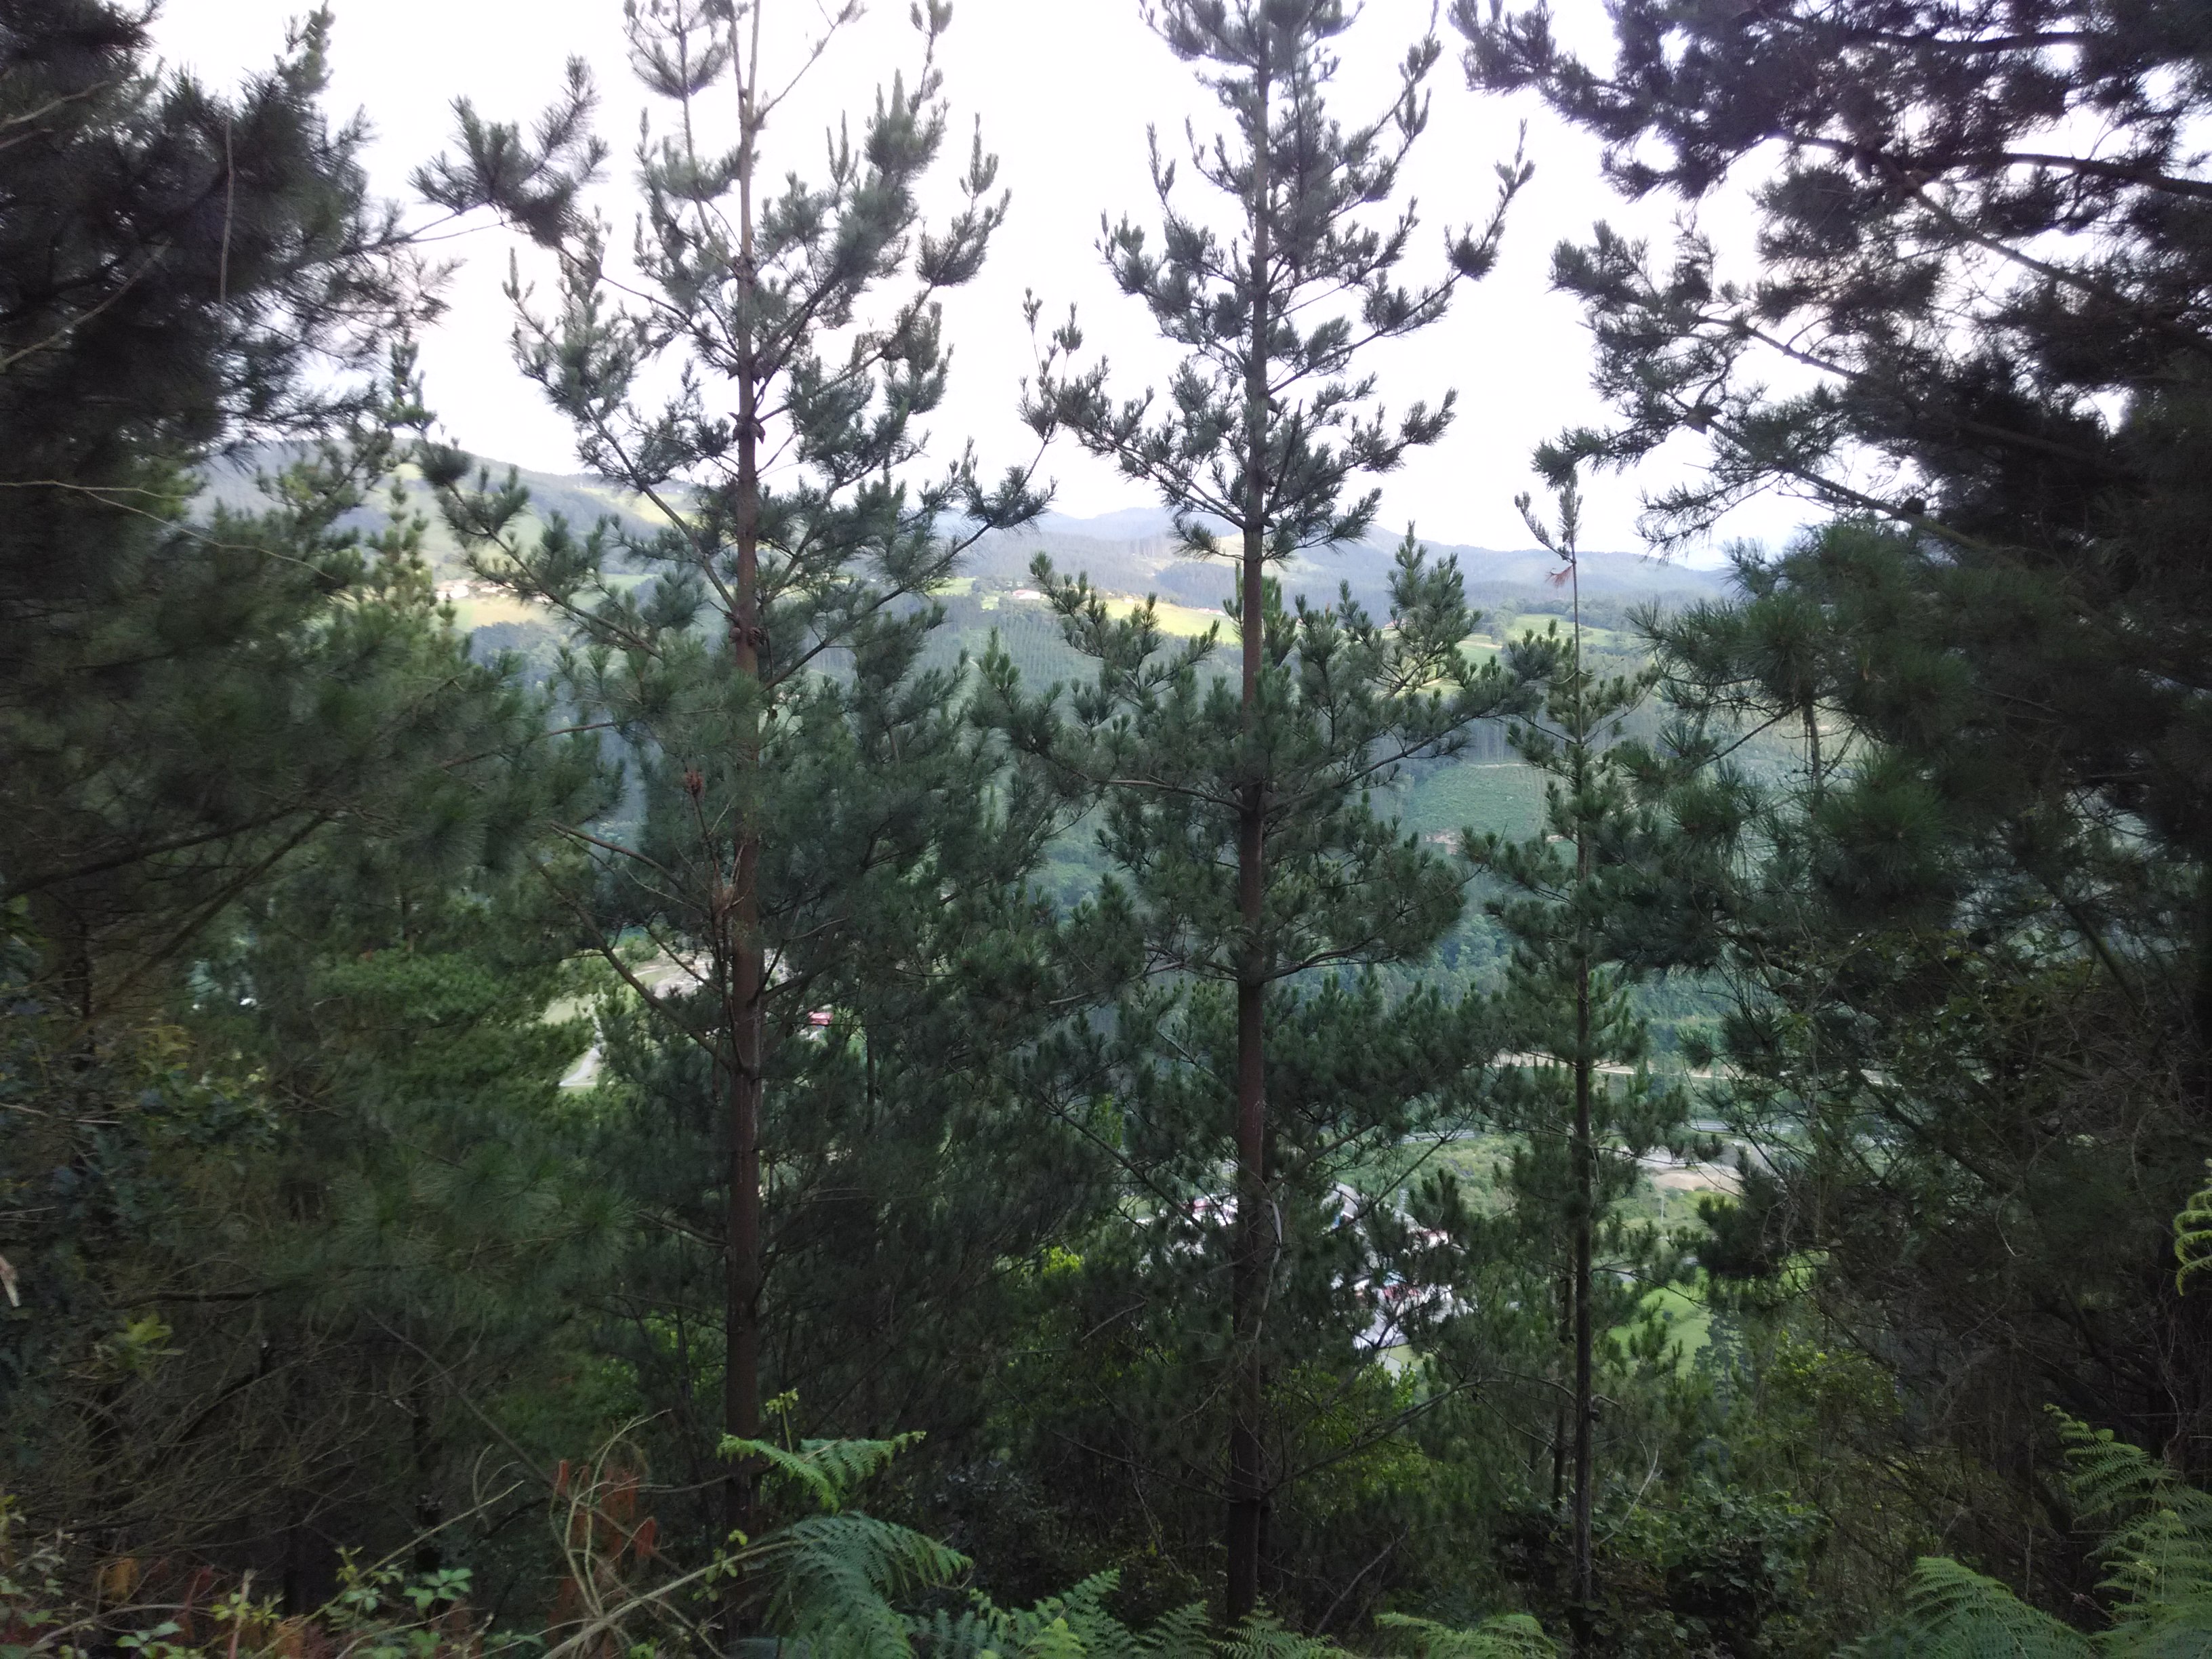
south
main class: Woodland
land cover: Pine dominated coniferous woodland
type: exotic forest
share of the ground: > 75 %
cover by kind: coniferous forest trees 80 %, shrubs 20 %
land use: Forestry
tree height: > 5 m
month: June
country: ES
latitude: 43.3245
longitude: -2.4463
